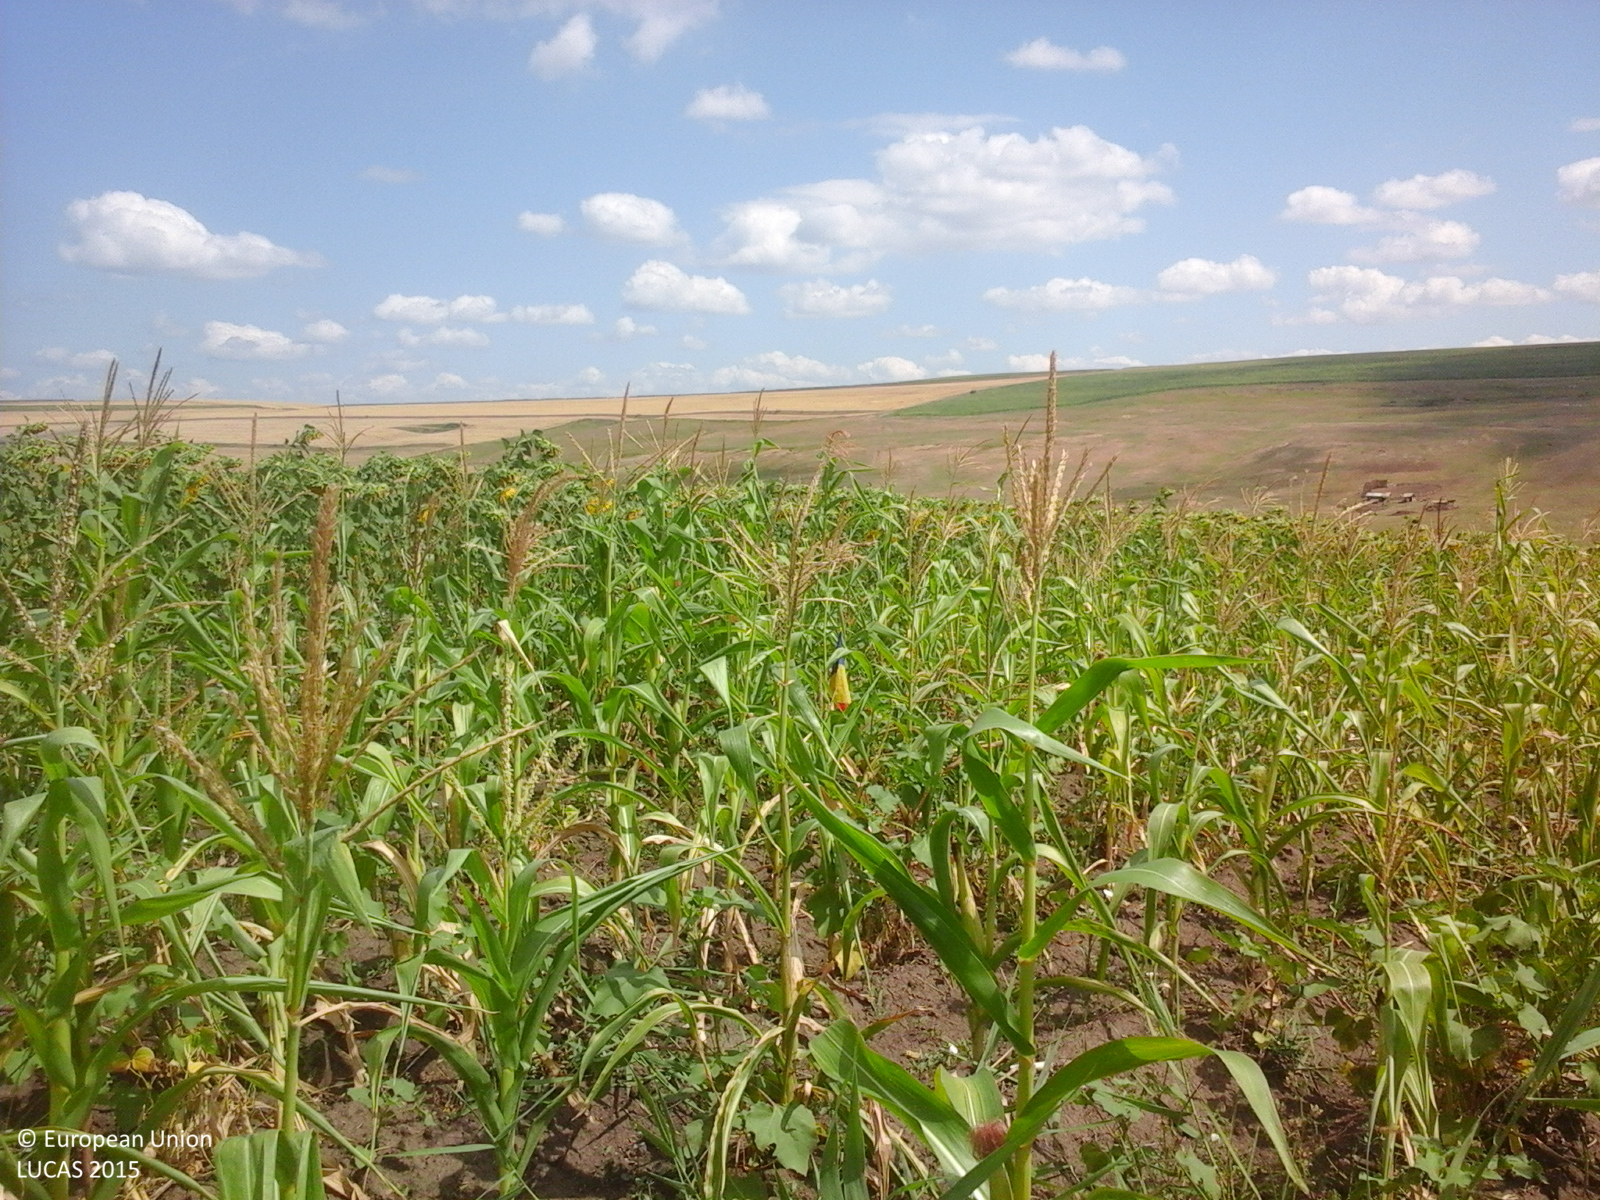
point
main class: Cropland
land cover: Maize
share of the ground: > 75 %
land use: Agriculture (excluding fallow land and kitchen gardens)
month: July
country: RO
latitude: 46.3660
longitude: 27.9443
